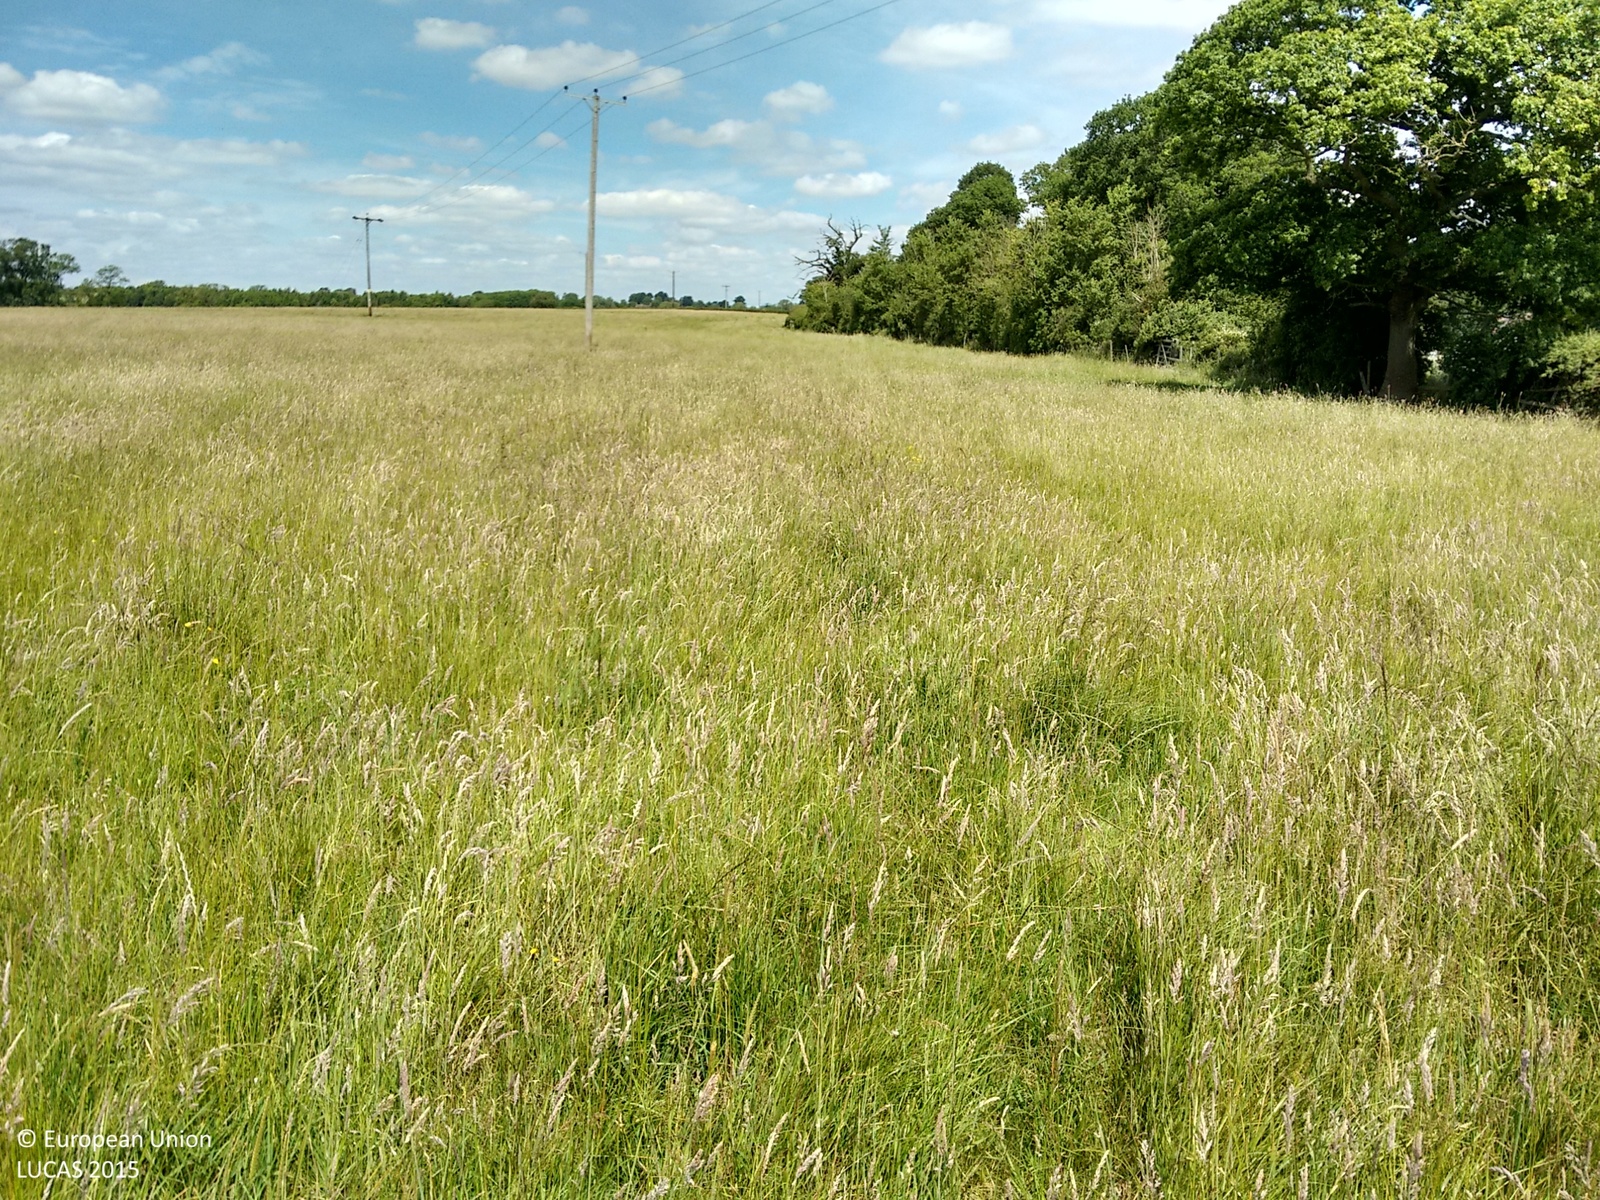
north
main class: Grassland
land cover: Grassland without tree/shrub cover
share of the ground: > 75 %
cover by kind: herbaceous plants 100 %
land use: Agriculture (excluding fallow land and kitchen gardens)
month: June
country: GB
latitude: 51.6254
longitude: -1.5943
